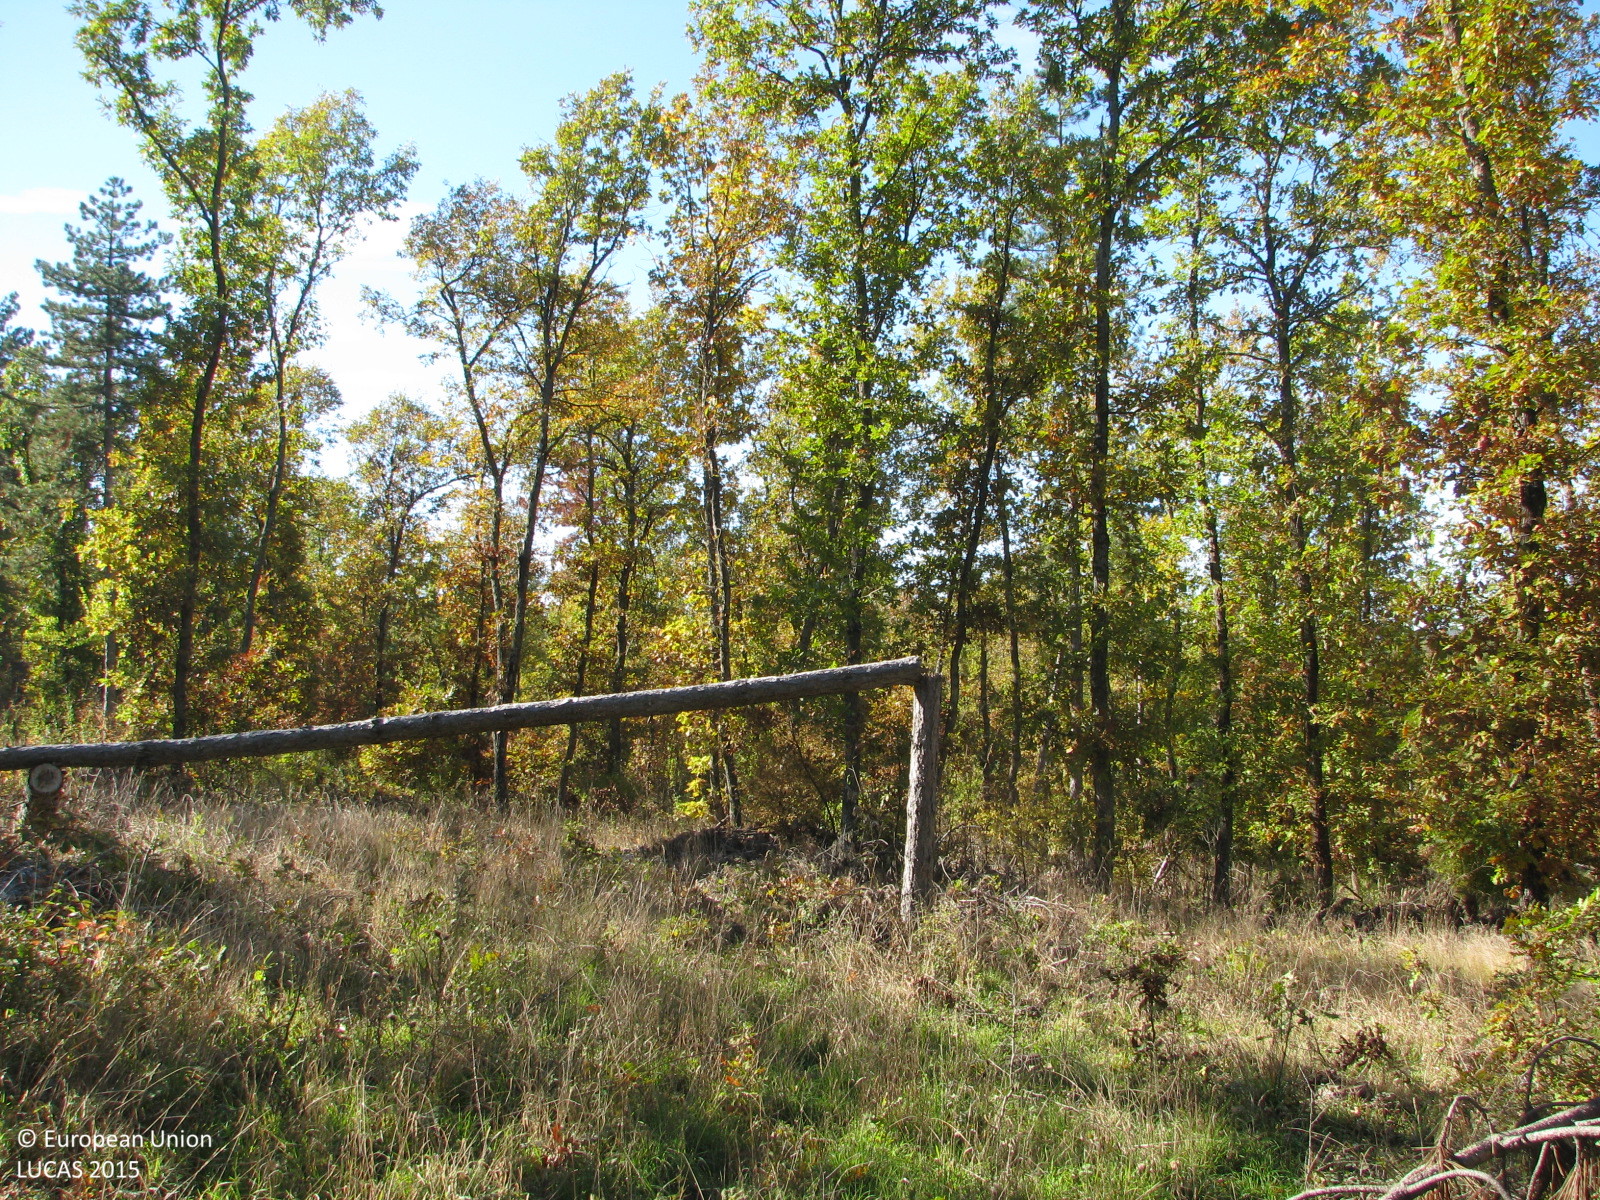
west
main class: Woodland
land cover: Pine dominated mixed woodland
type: hemiboreal forest and nemoral coniferous forest and mixed broadleaved-coniferous forest
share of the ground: 25 - 50 %
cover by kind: herbaceous plants 40 %, coniferous forest trees 30 %, broadleaved forest trees 20 %, shrubs 10 %
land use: Forestry
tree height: > 5 m
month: November
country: BG
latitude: 41.9901
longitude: 26.7123
